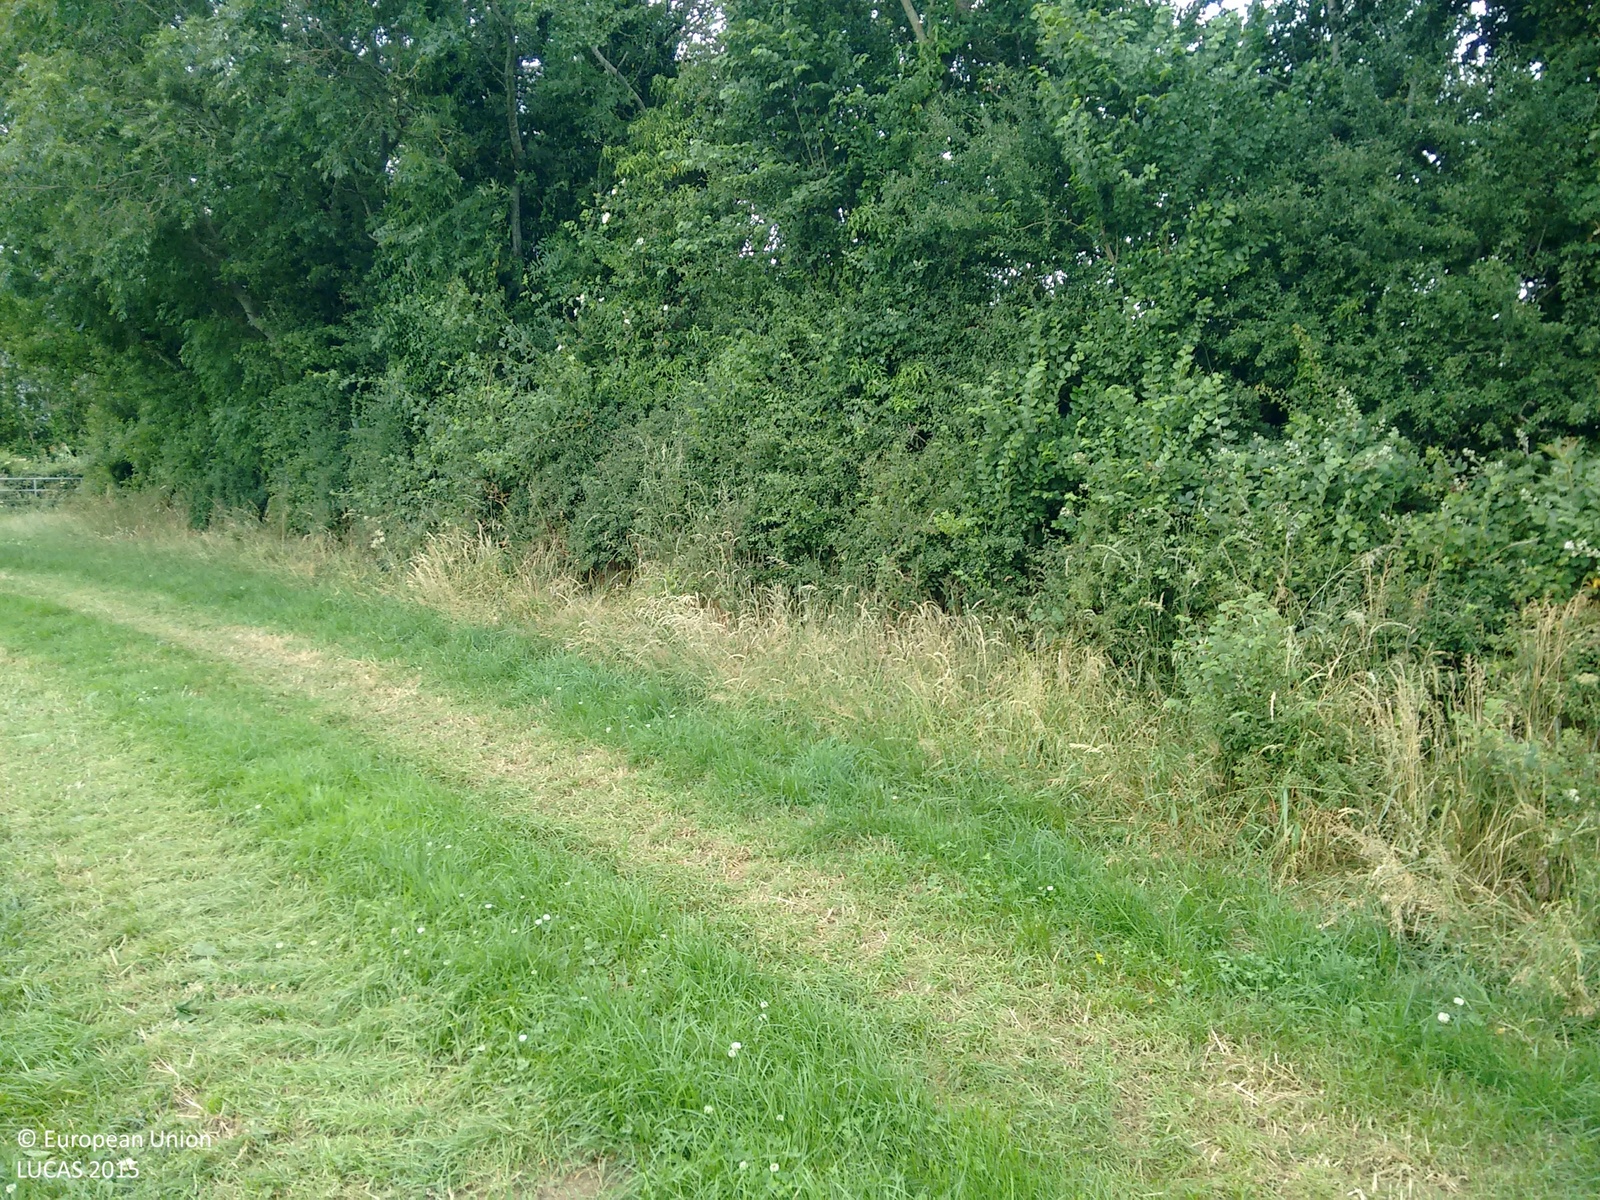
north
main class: Grassland
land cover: Grassland without tree/shrub cover
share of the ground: > 75 %
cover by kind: herbaceous plants 100 %
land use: Agriculture (excluding fallow land and kitchen gardens)
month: July
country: IE
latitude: 52.7213
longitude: -7.4958
